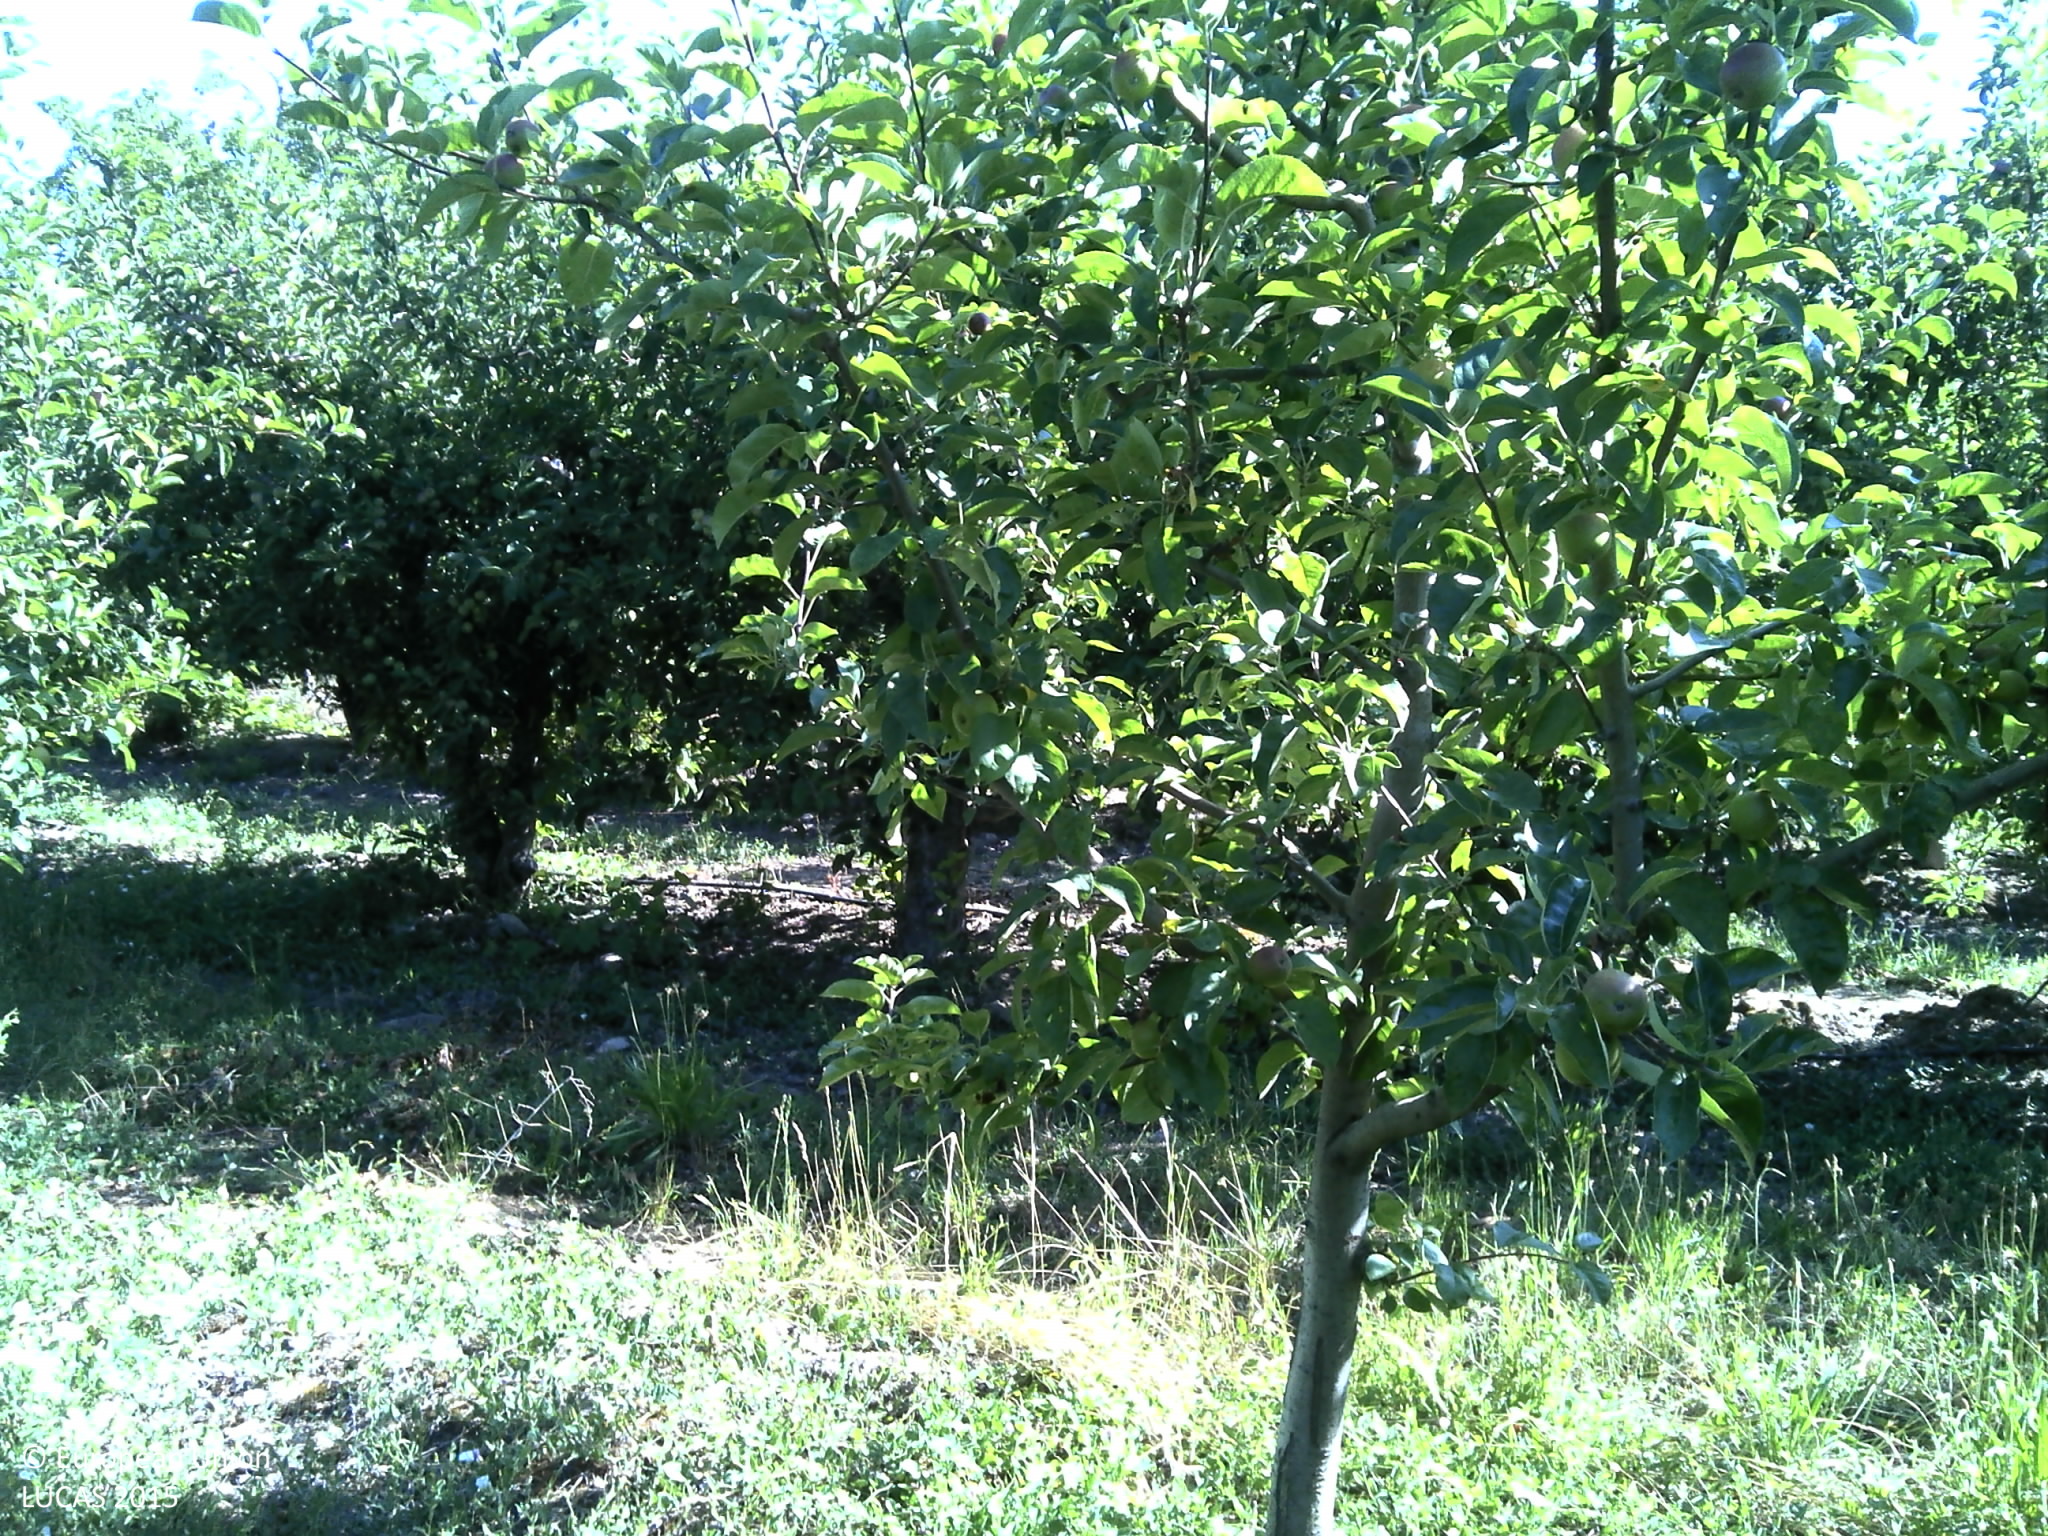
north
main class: Cropland
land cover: Apple fruit
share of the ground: 50 - 75 %
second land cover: Grassland without tree/shrub cover
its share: 25 - 50 %
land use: Agriculture (excluding fallow land and kitchen gardens)
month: June
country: PT
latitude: 40.9950
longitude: -7.5598
